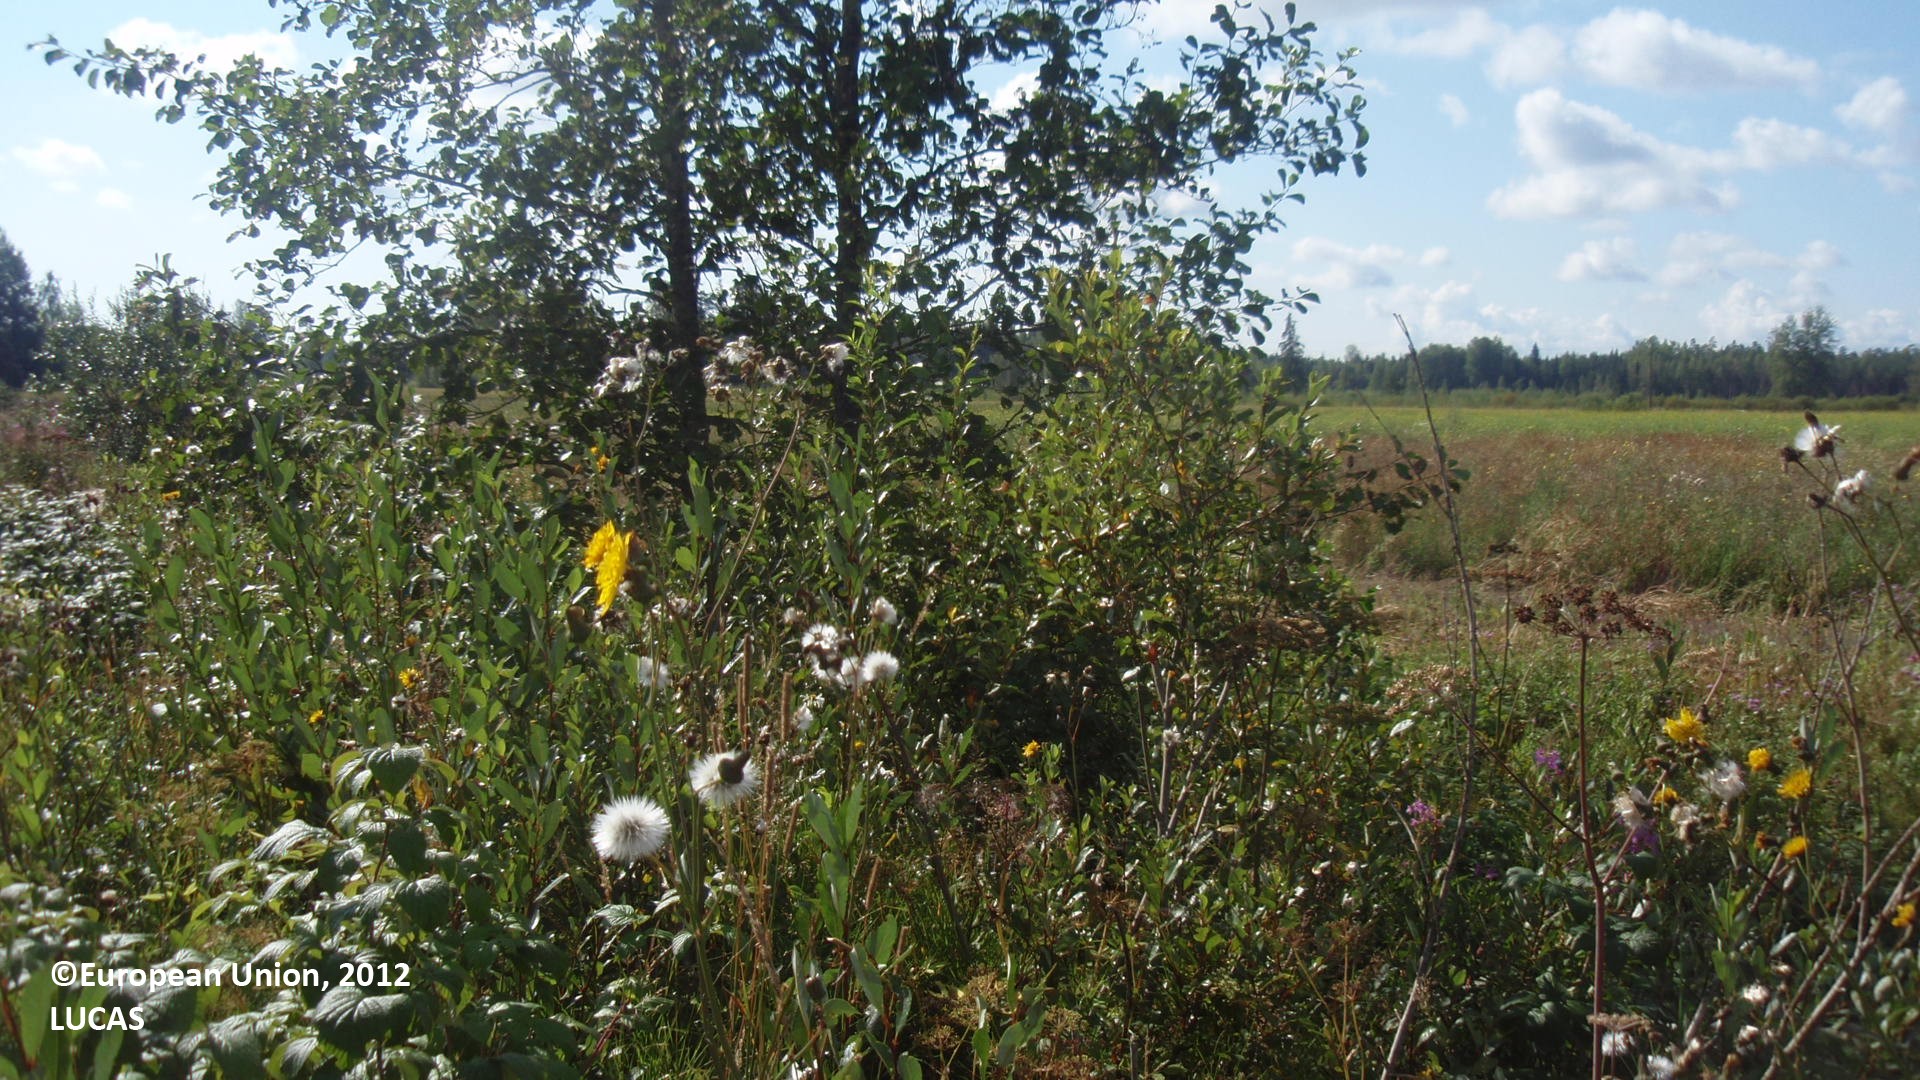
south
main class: Cropland
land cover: Temporary grasslands
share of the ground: > 75 %
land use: Agriculture (excluding fallow land and kitchen gardens)
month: August
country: FI
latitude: 60.7672
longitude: 26.6611
